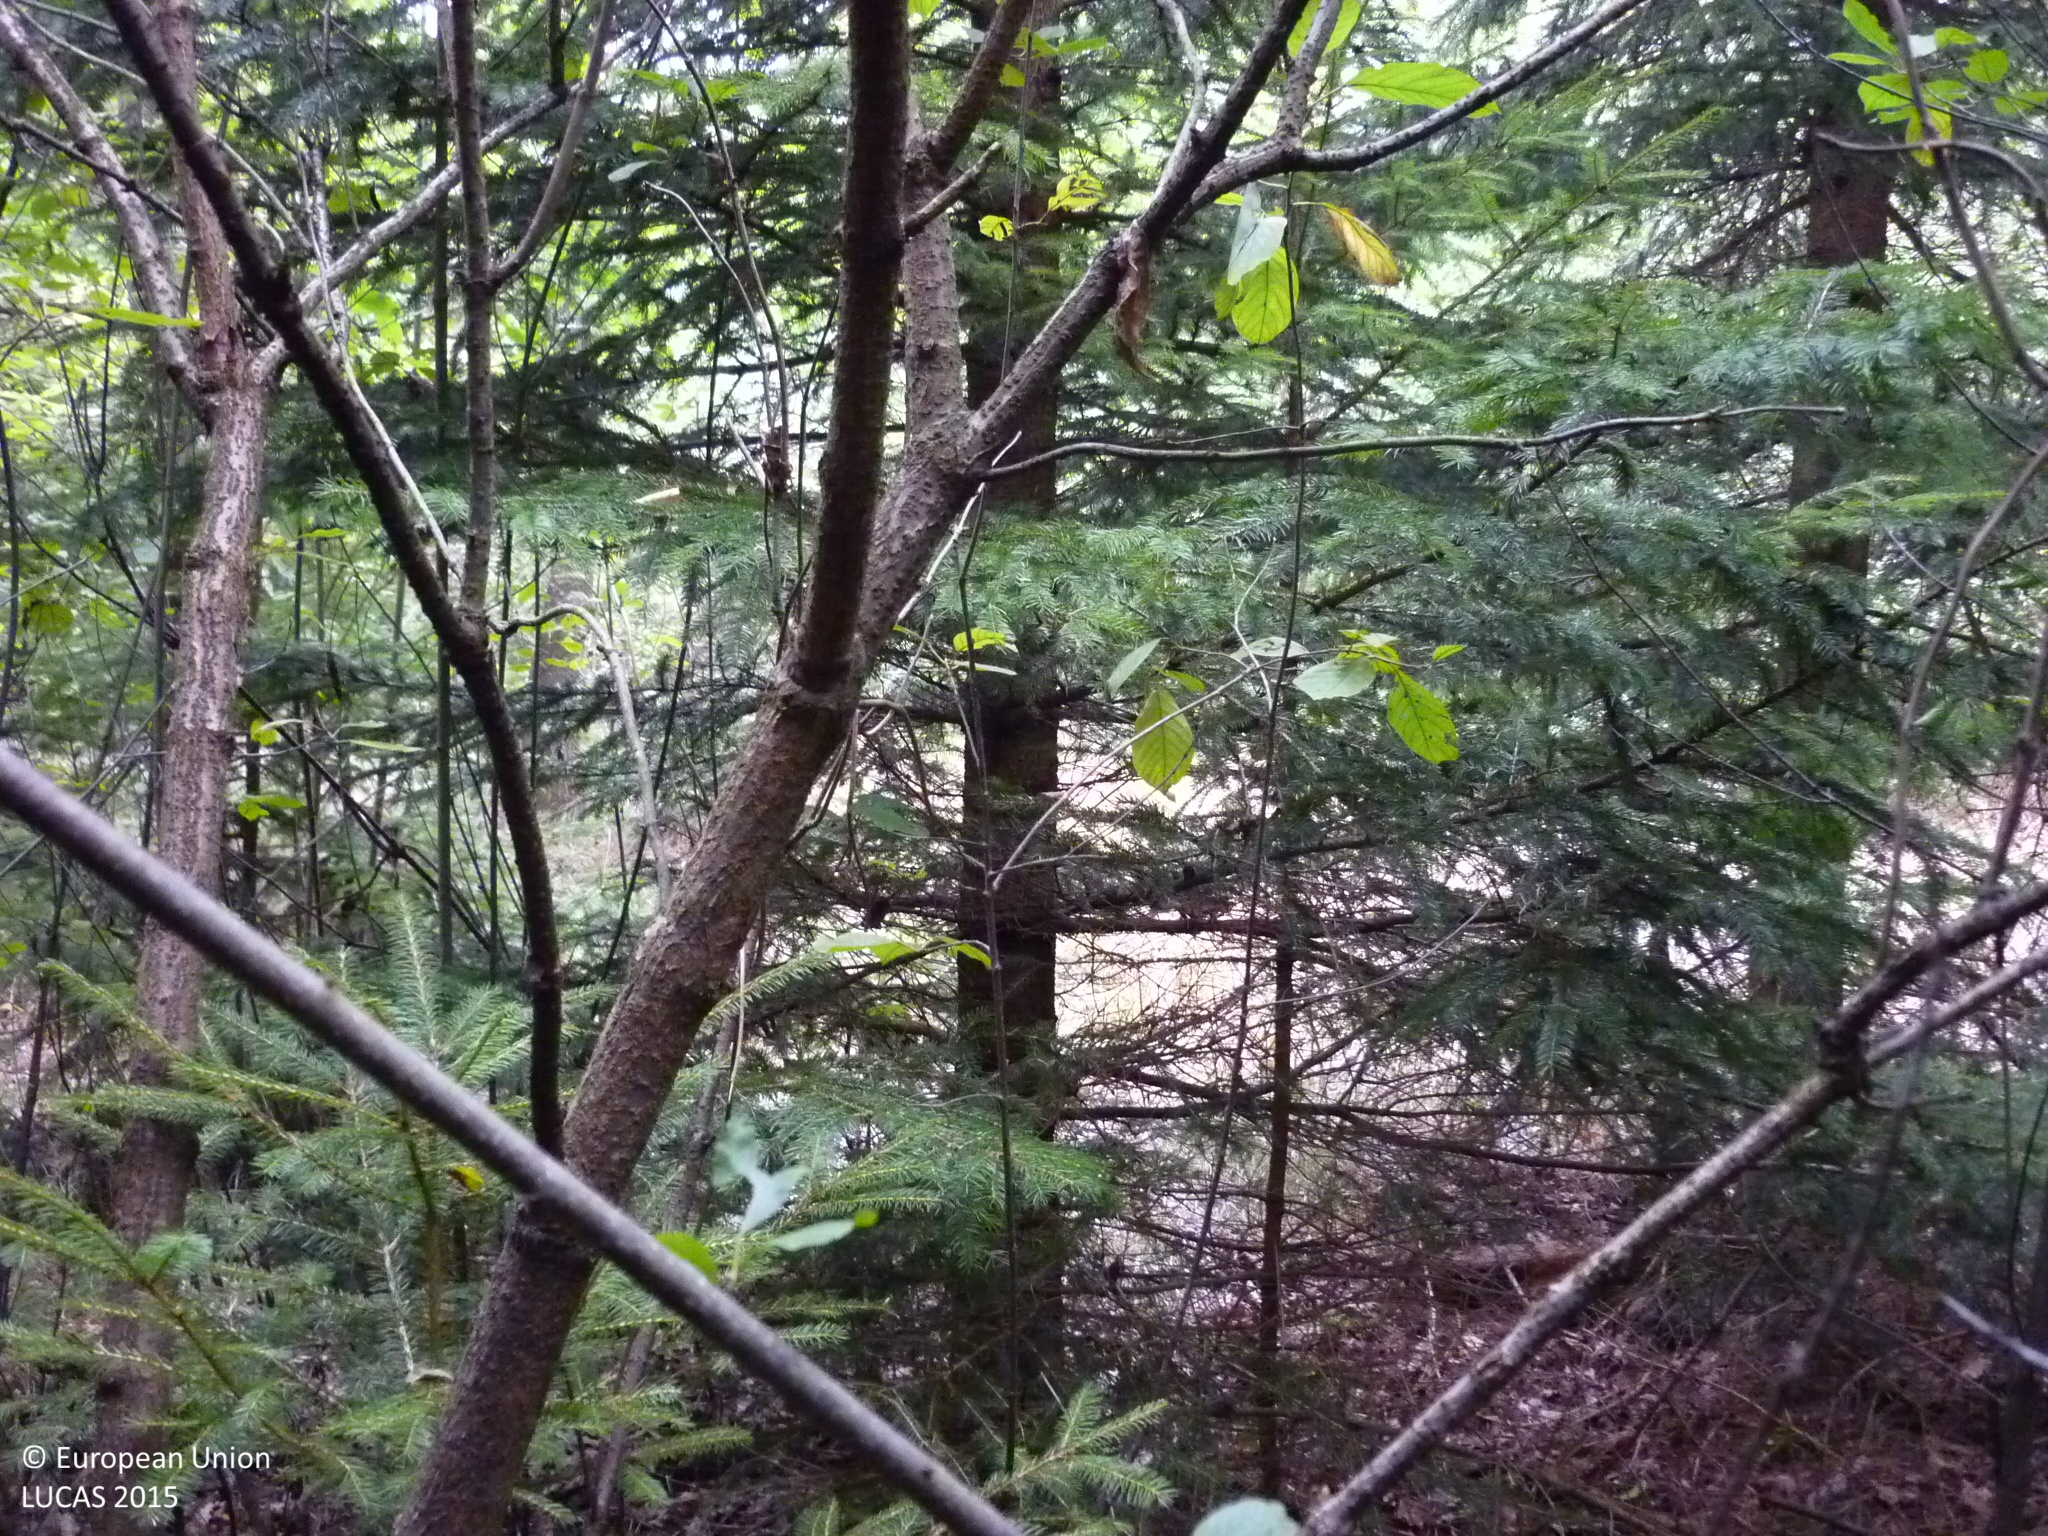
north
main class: Woodland
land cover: Spruce dominated mixed woodland
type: hemiboreal forest and nemoral coniferous forest and mixed broadleaved-coniferous forest
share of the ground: > 75 %
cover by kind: coniferous forest trees 70 %, broadleaved forest trees 30 %
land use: Forestry
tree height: > 5 m
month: September
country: AT
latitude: 48.8120
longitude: 15.0269
